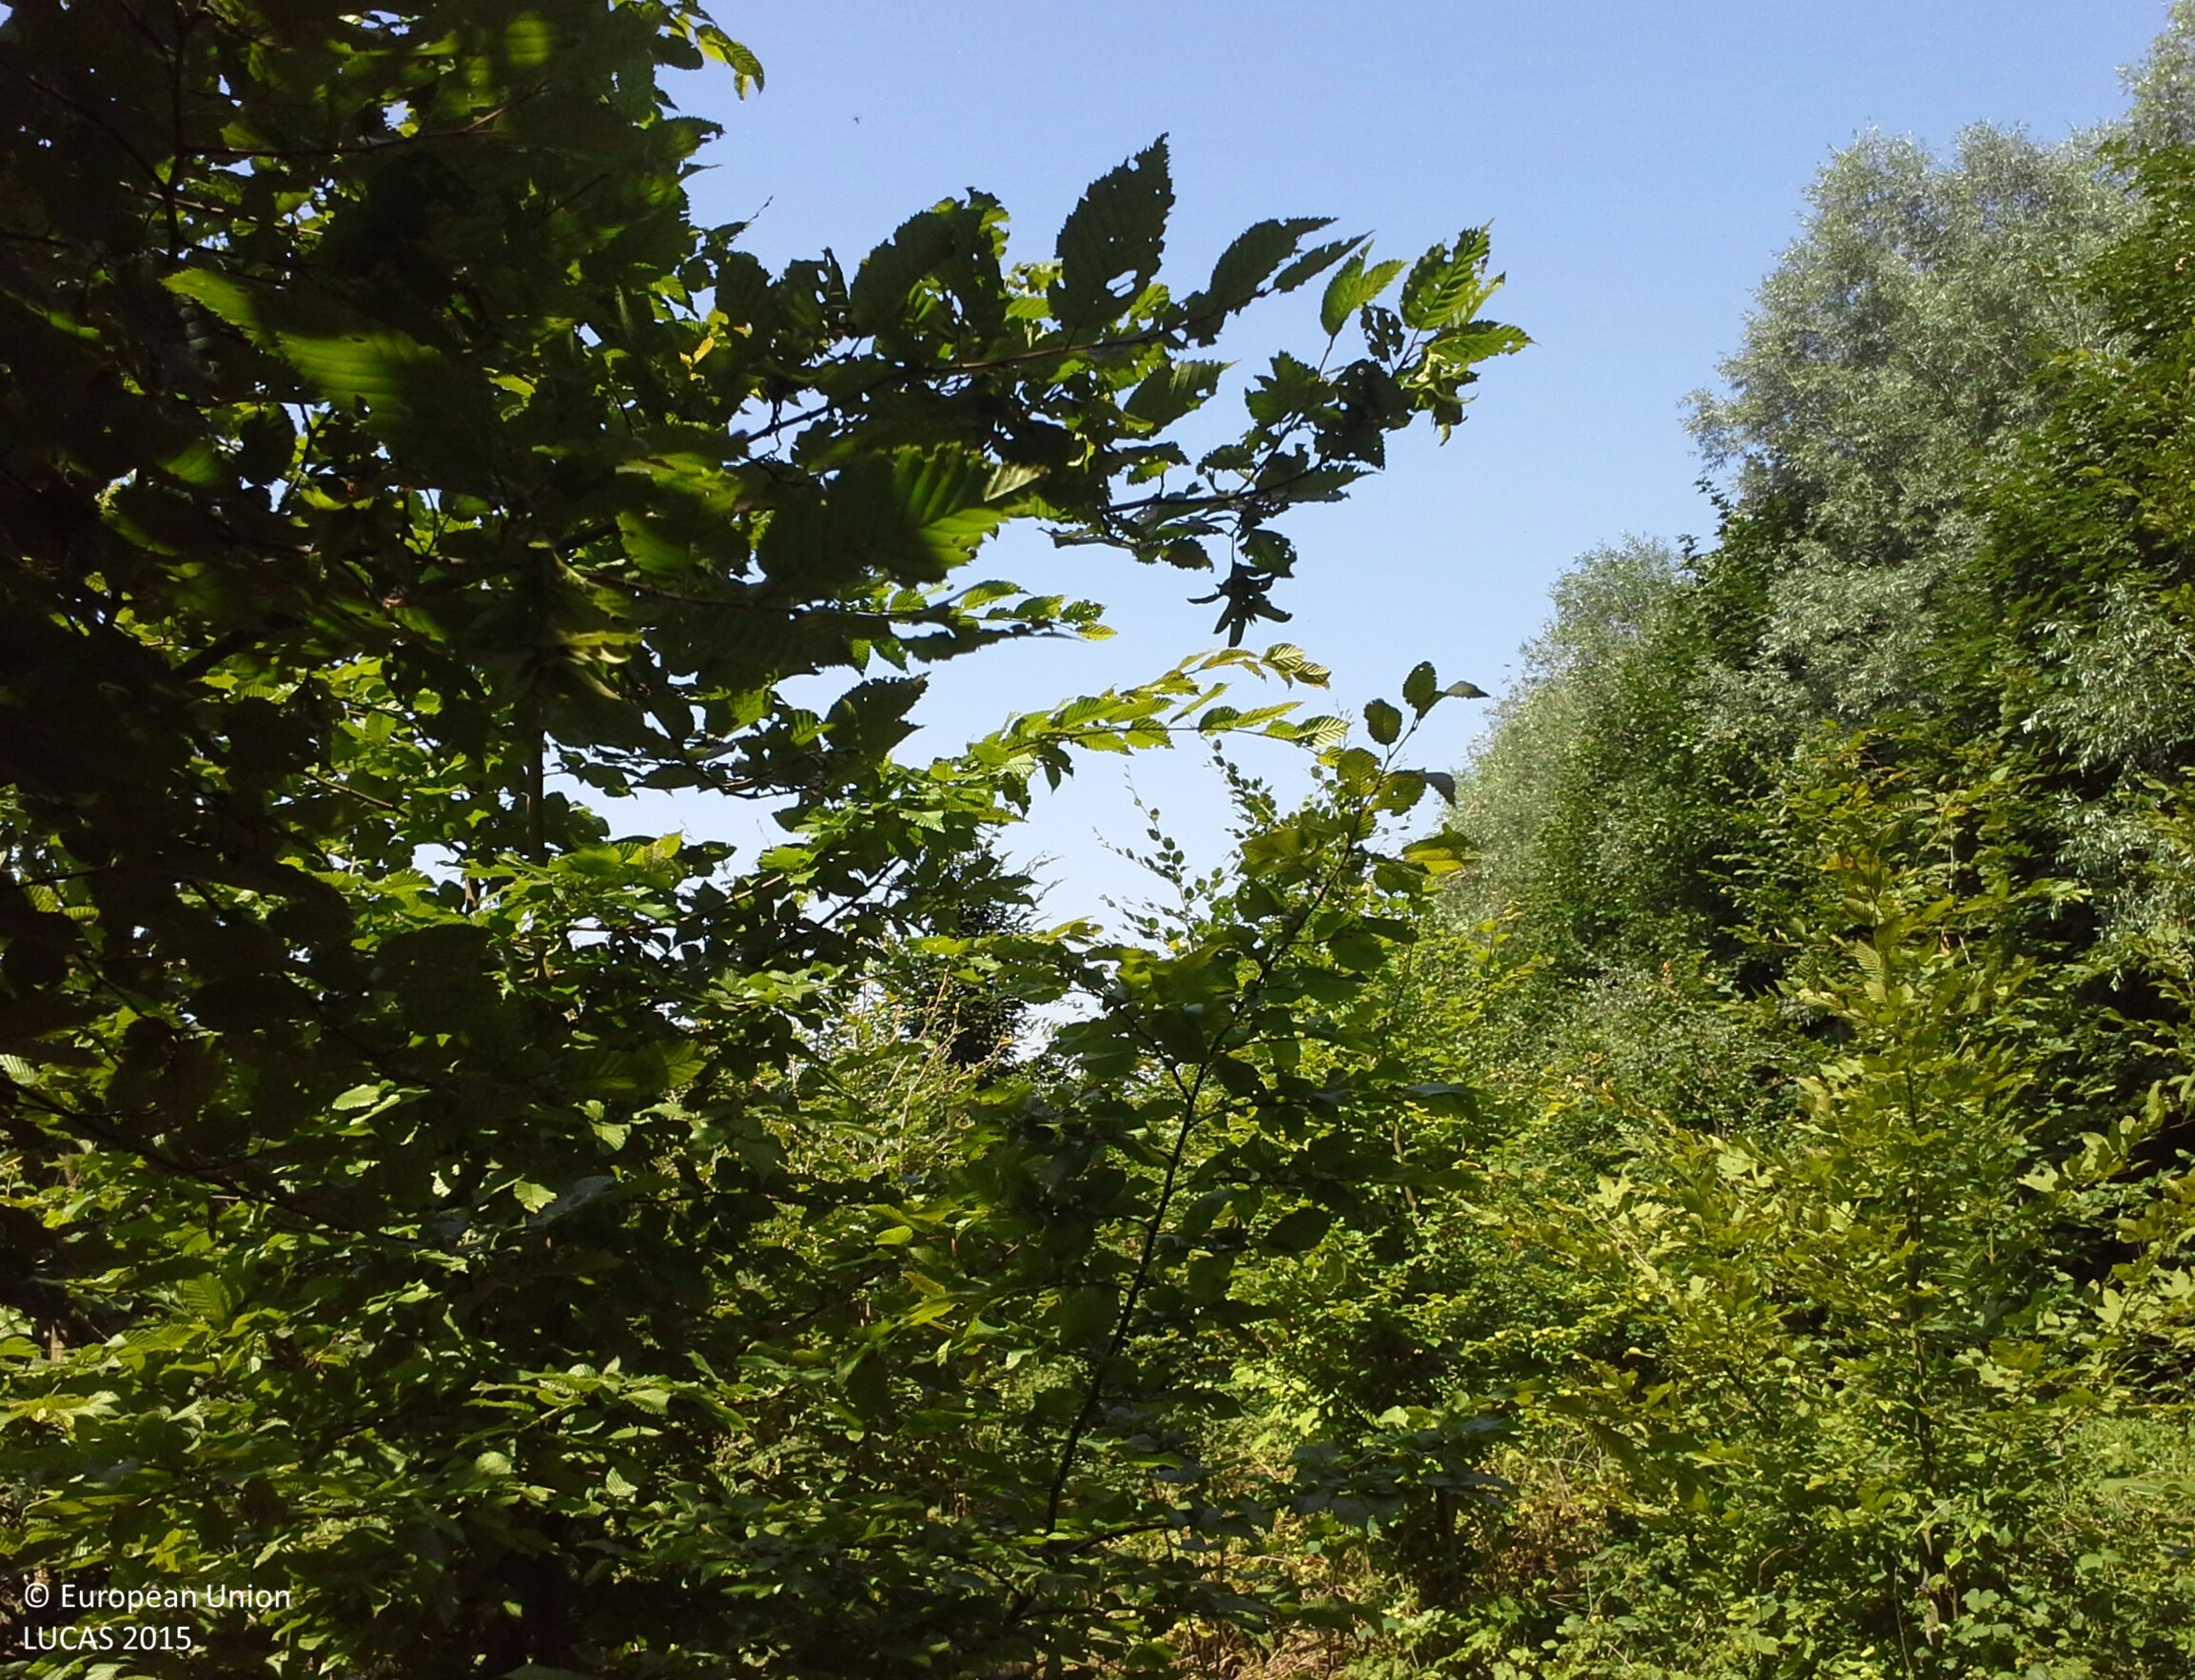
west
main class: Woodland
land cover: Broadleaved woodland
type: mesophytic deciduous forest
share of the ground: > 75 %
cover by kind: broadleaved forest trees 70 %, shrubs 15 %, herbaceous plants 15 %
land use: Forestry
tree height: < 5 m
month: July
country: AT
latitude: 48.0989
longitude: 14.8483
